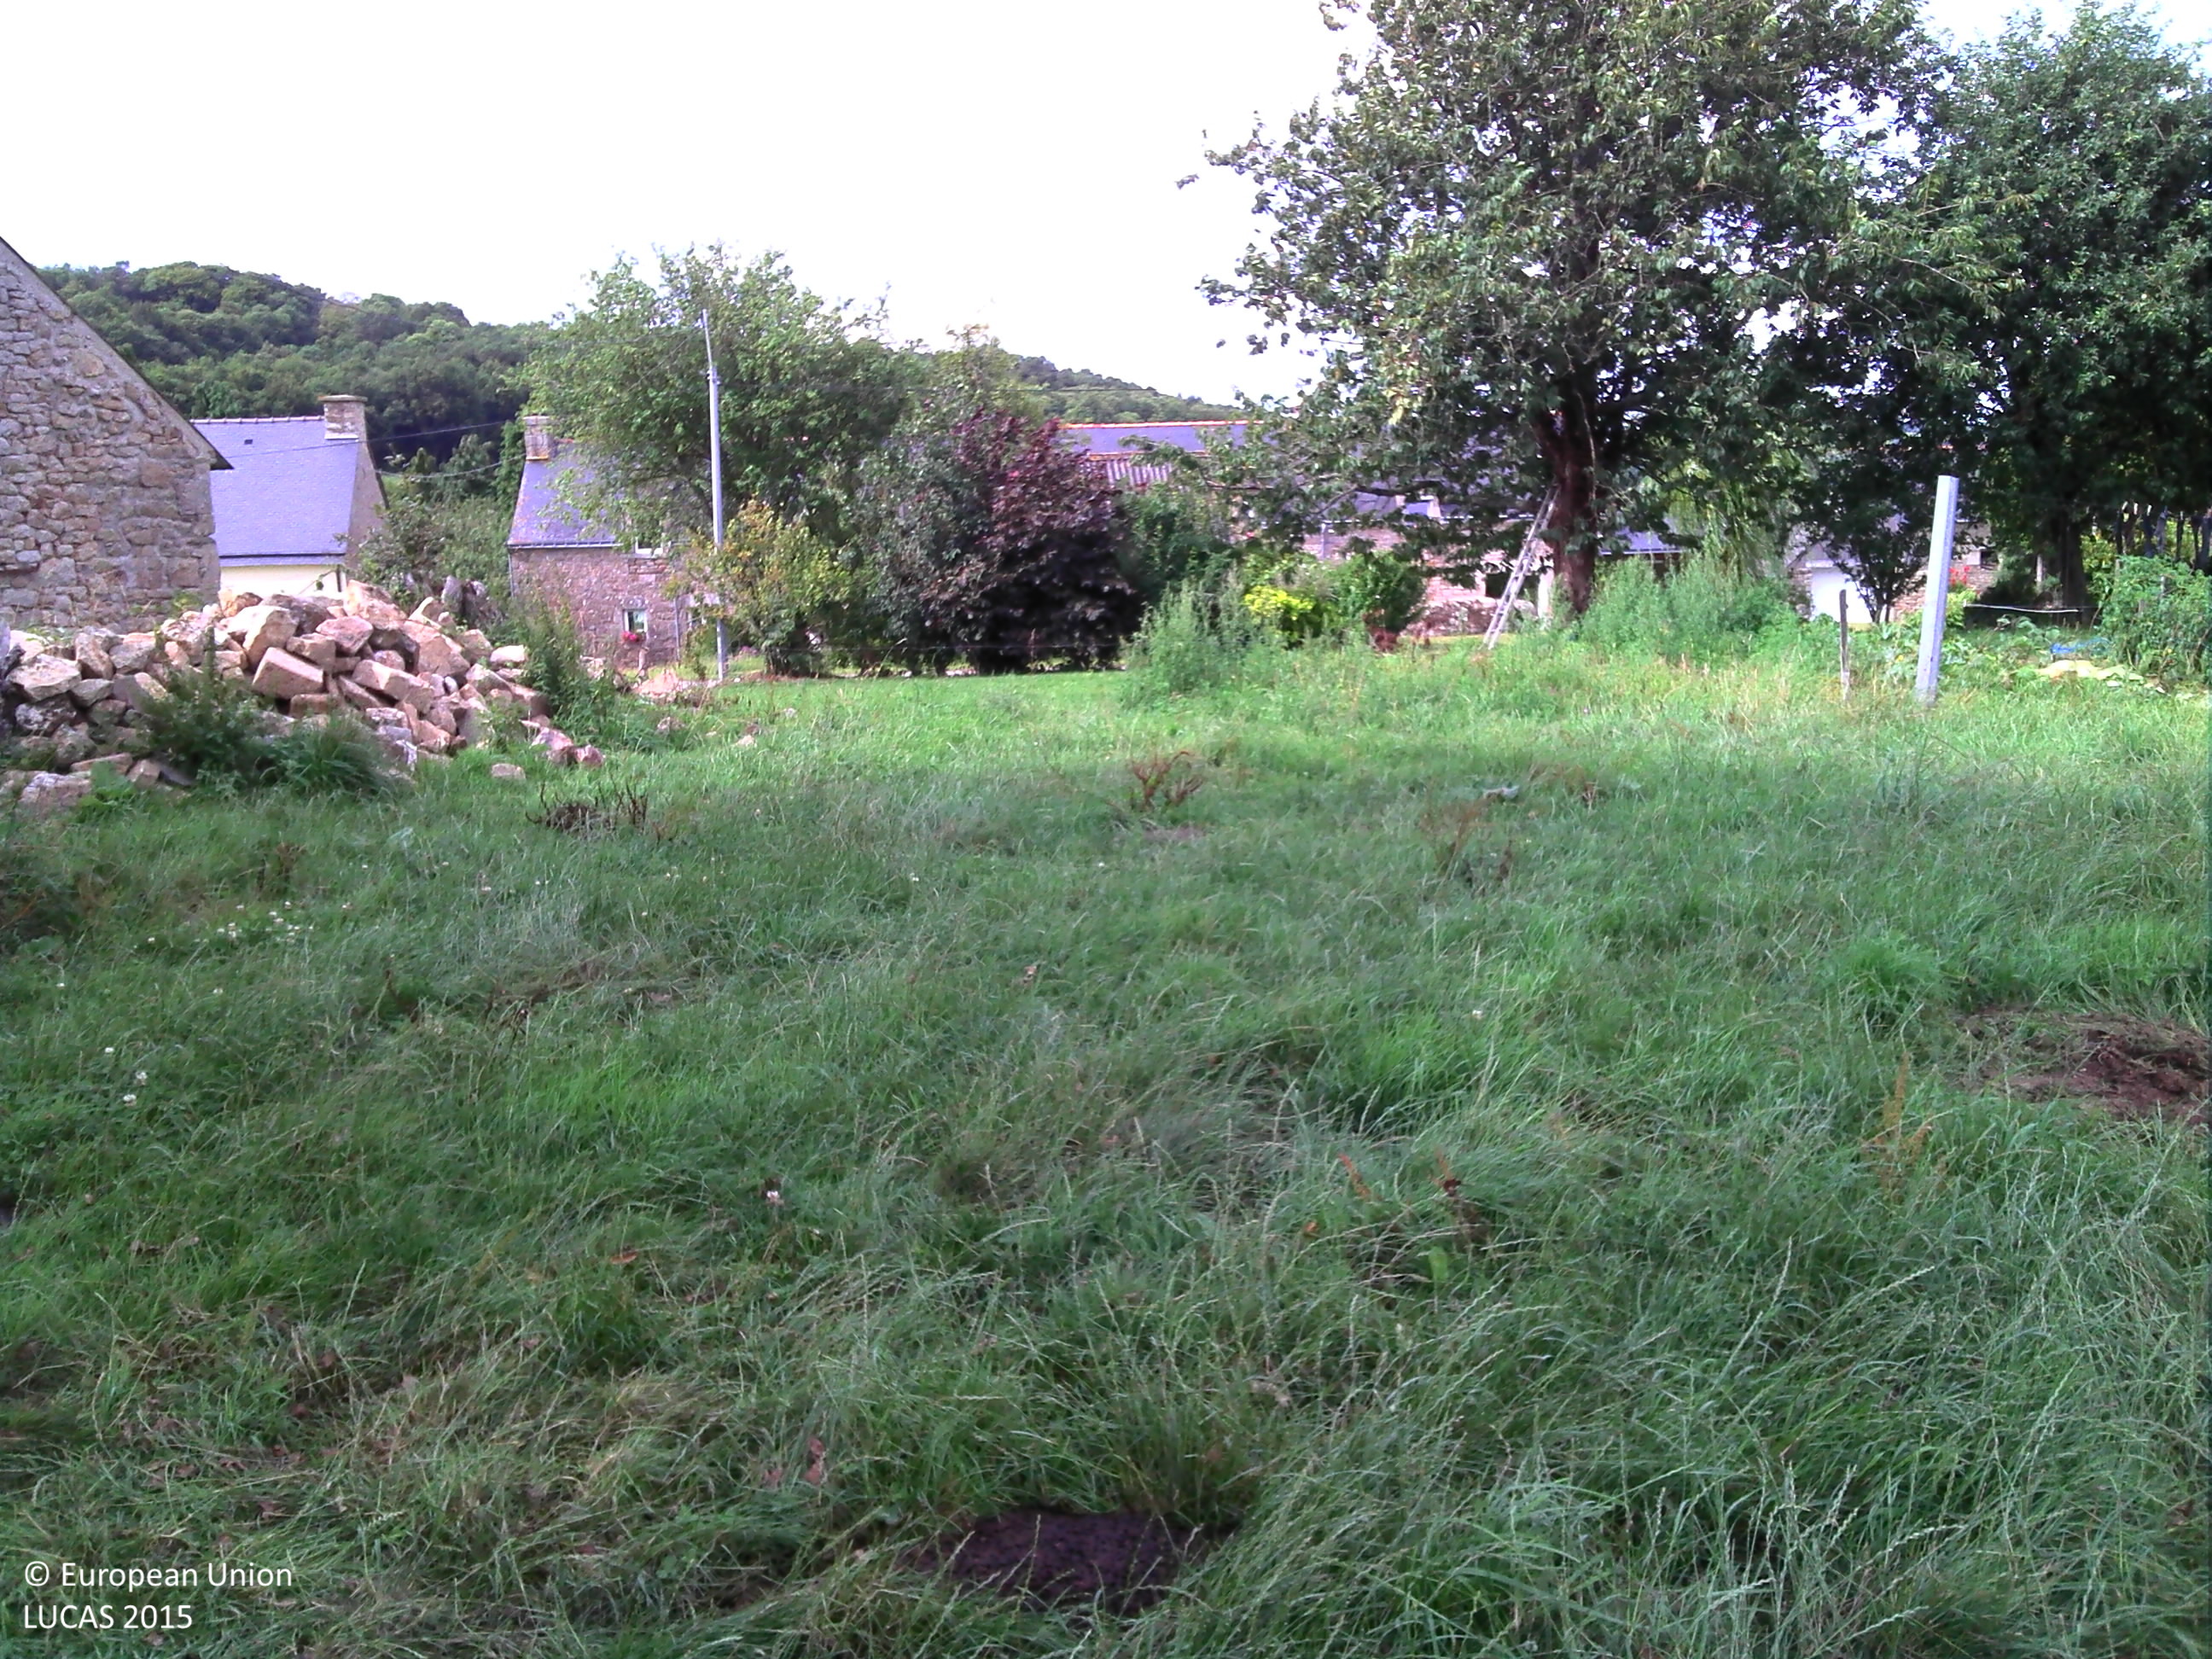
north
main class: Grassland
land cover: Grassland without tree/shrub cover
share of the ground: > 75 %
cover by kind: herbaceous plants 70 %, consolidated bare surface 30 %
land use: Agriculture (excluding fallow land and kitchen gardens)
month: July
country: FR
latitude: 47.9112
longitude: -2.9511
